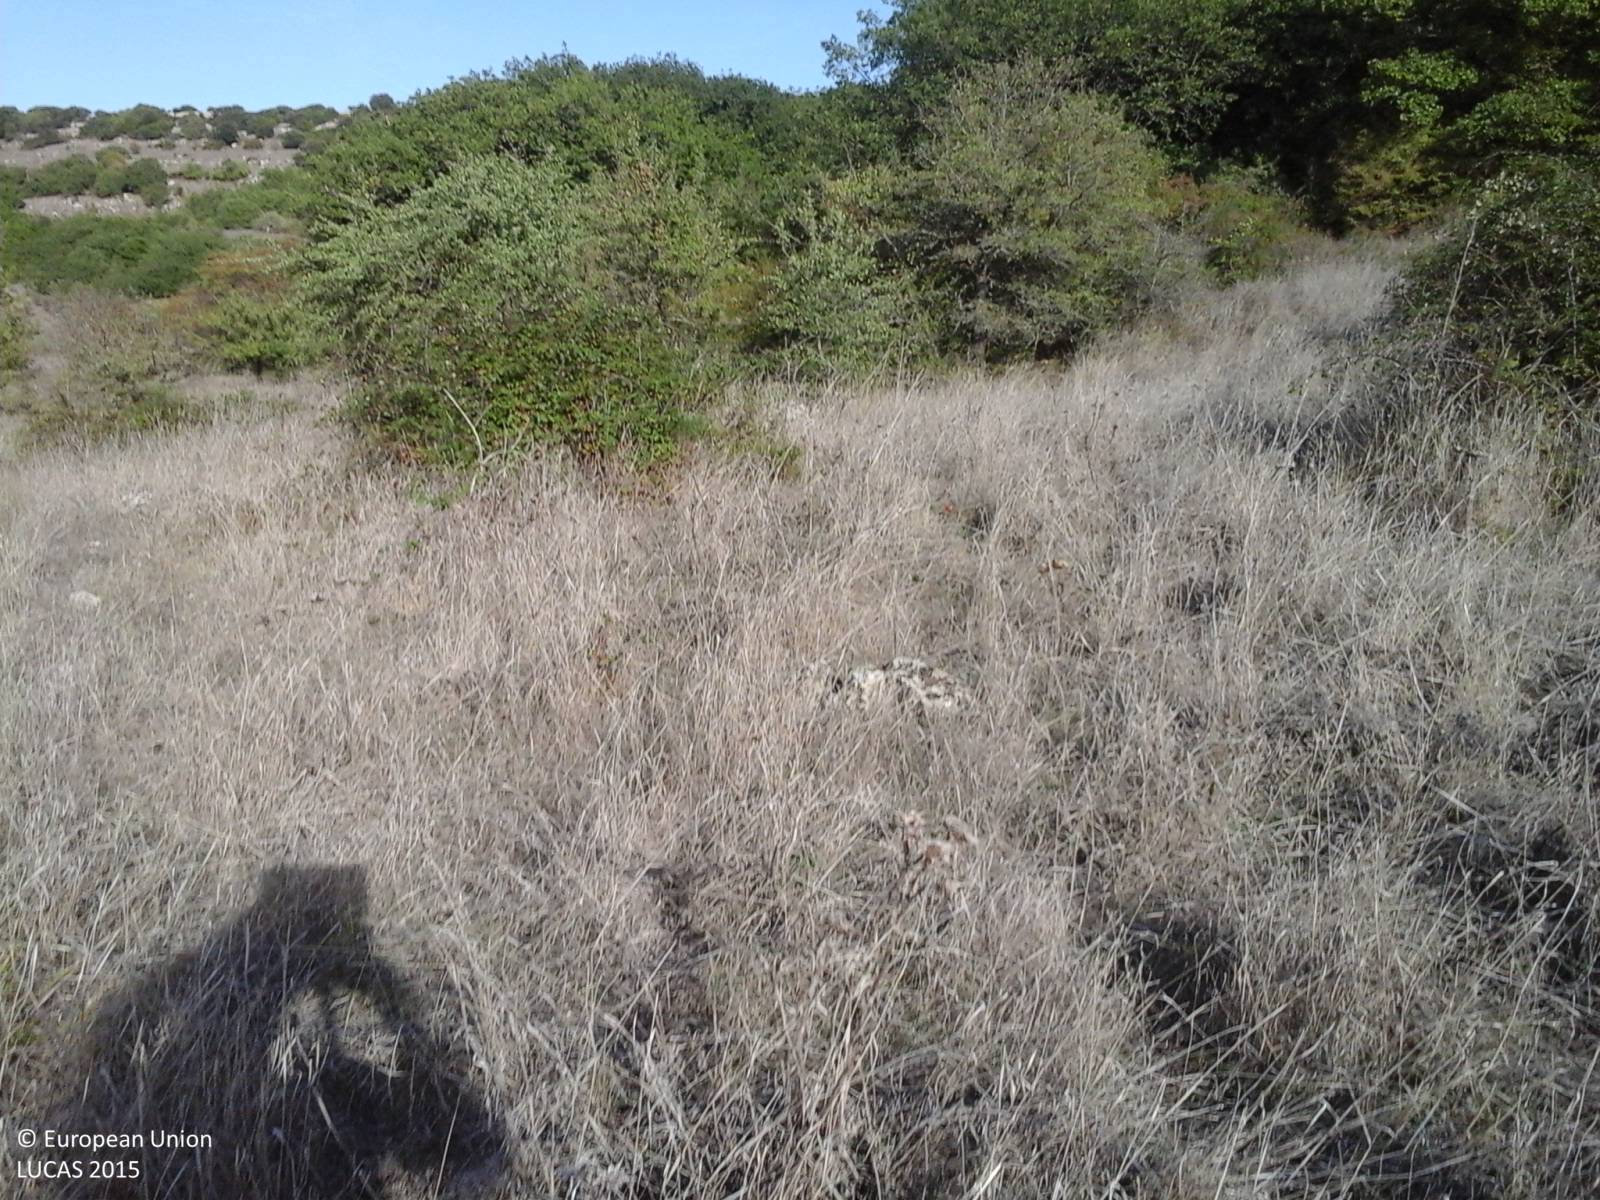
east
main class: Grassland
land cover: Grassland without tree/shrub cover
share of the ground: > 75 %
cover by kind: herbaceous plants 100 %
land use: Agriculture (excluding fallow land and kitchen gardens)
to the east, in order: Grassland without tree/shrub cover; Shrubland with sparse tree cover; Broadleaved woodland; Shrubland with sparse tree cover
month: October
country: IT
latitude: 40.4019
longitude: 8.5815
